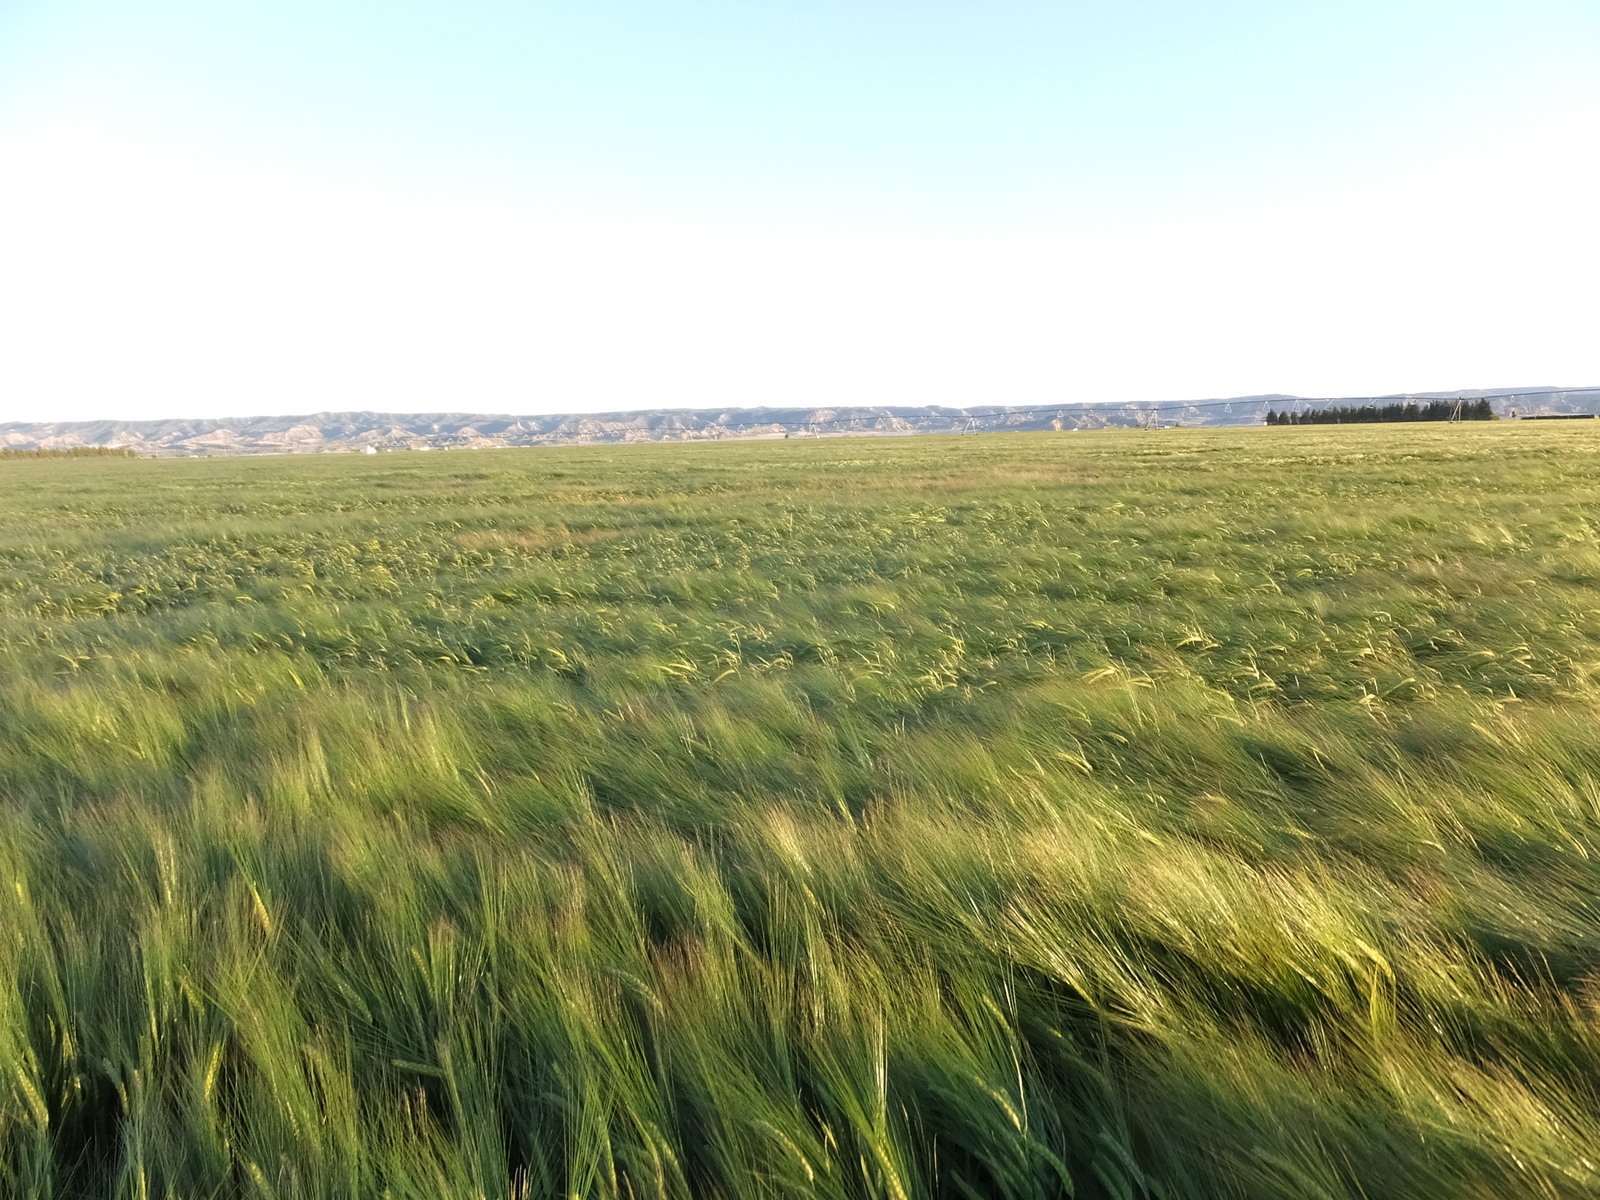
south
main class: Cropland
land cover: Barley
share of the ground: > 75 %
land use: Agriculture (excluding fallow land and kitchen gardens)
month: May
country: ES
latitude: 41.7447
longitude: -0.1303
